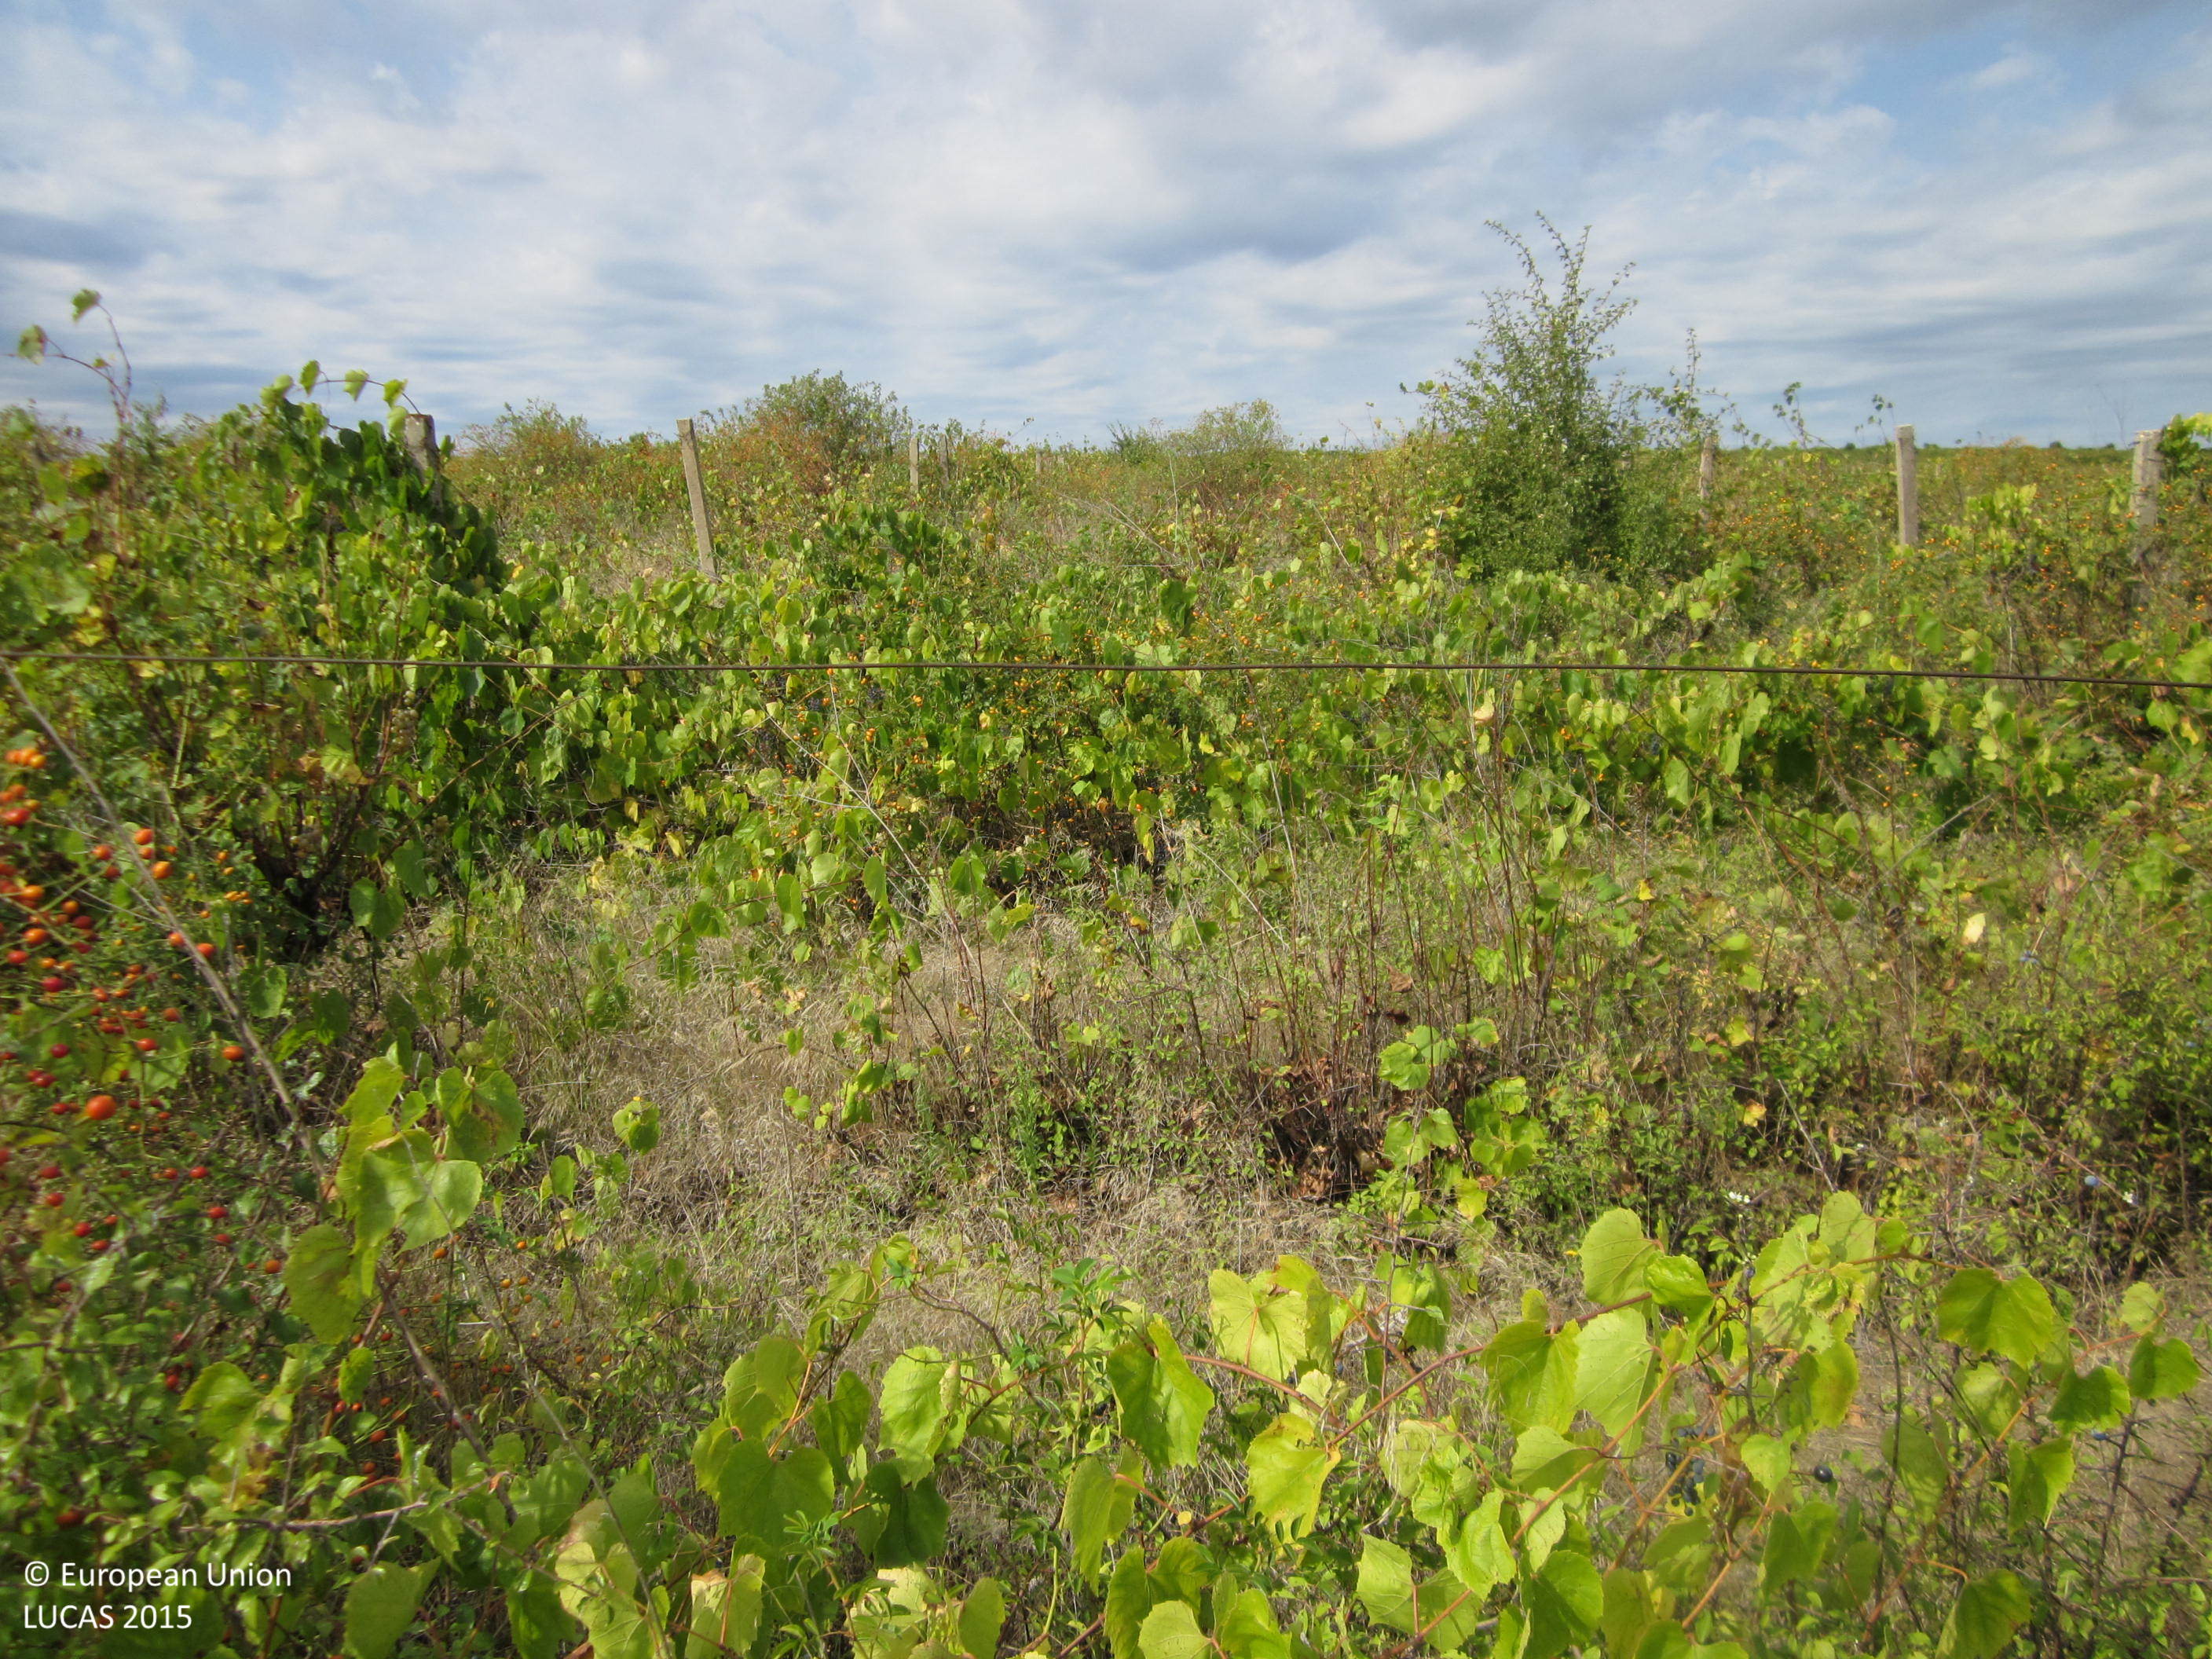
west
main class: Cropland
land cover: Vineyards
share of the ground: 50 - 75 %
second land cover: Spontaneously vegetated surfaces
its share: > 75 %
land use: Agriculture (excluding fallow land and kitchen gardens)
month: September
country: BG
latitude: 42.6908
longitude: 27.1377
